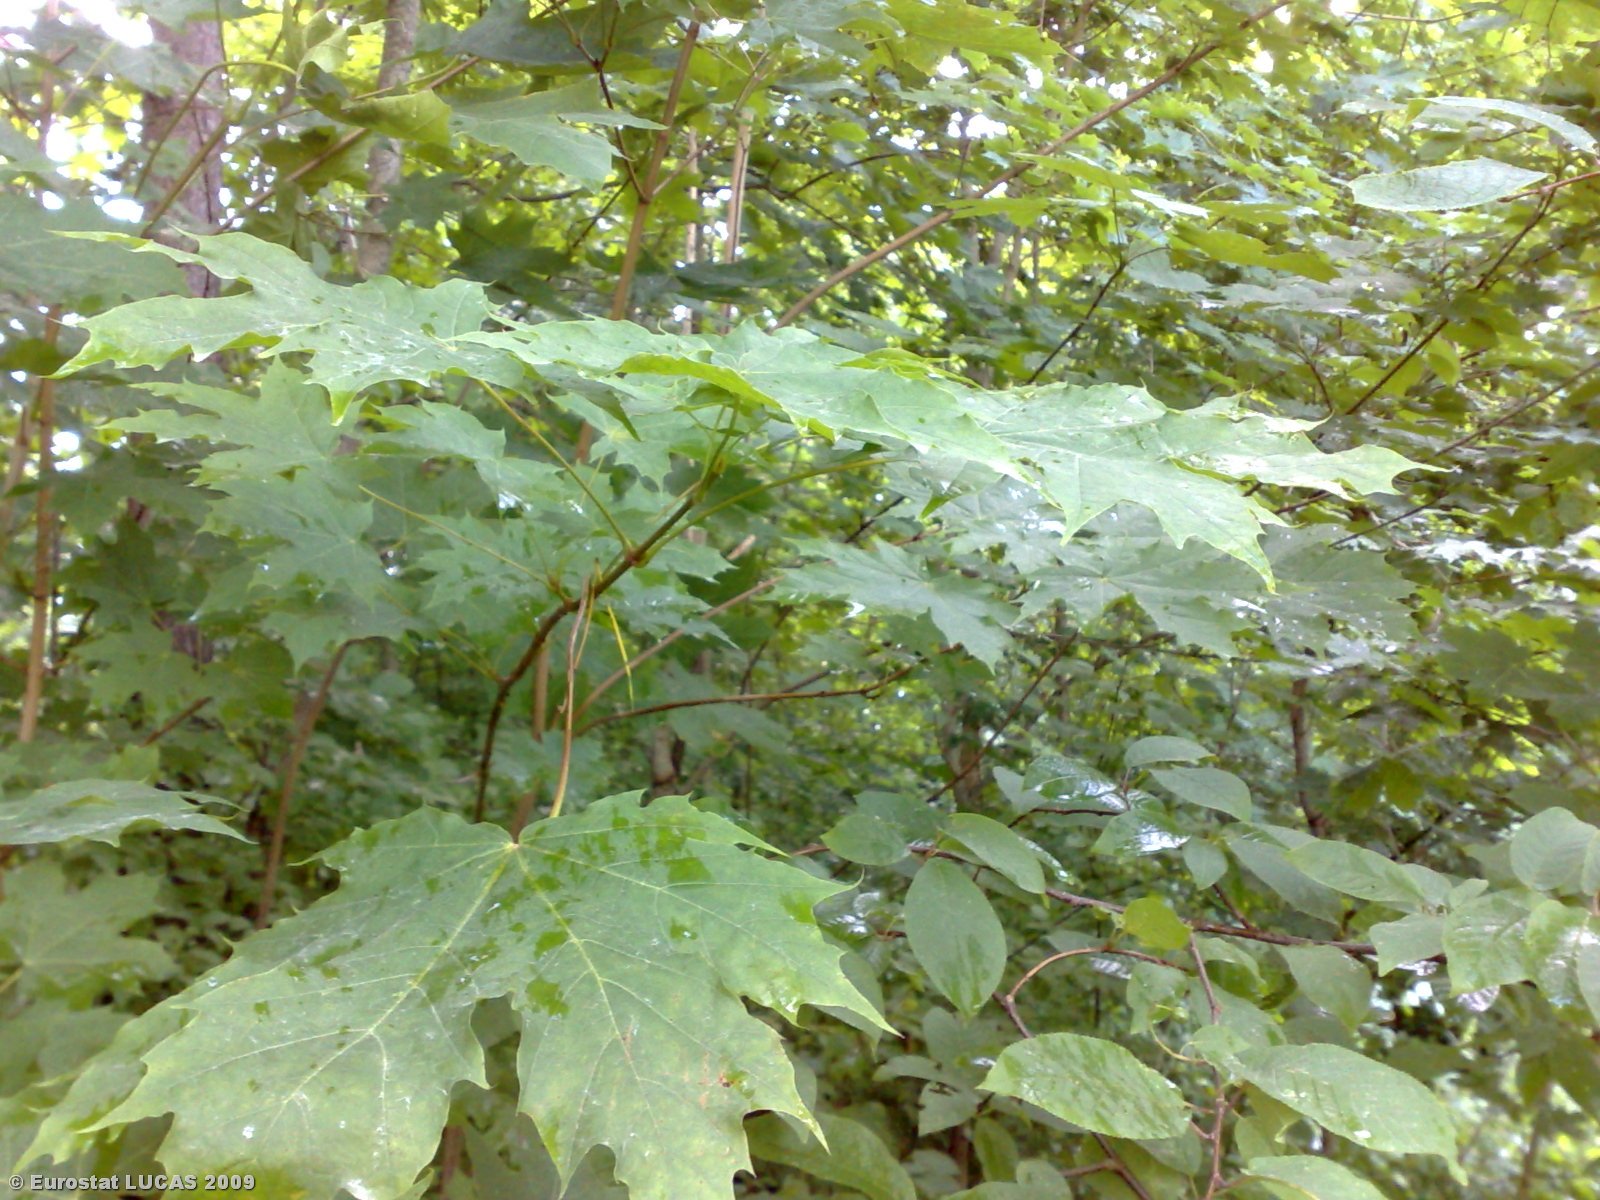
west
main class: Woodland
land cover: Broadleaved woodland
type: non-riverine alder, birch or aspen forest
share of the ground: > 75 %
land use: Forestry
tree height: > 5 m
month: July
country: LT
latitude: 55.6563
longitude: 22.7641
